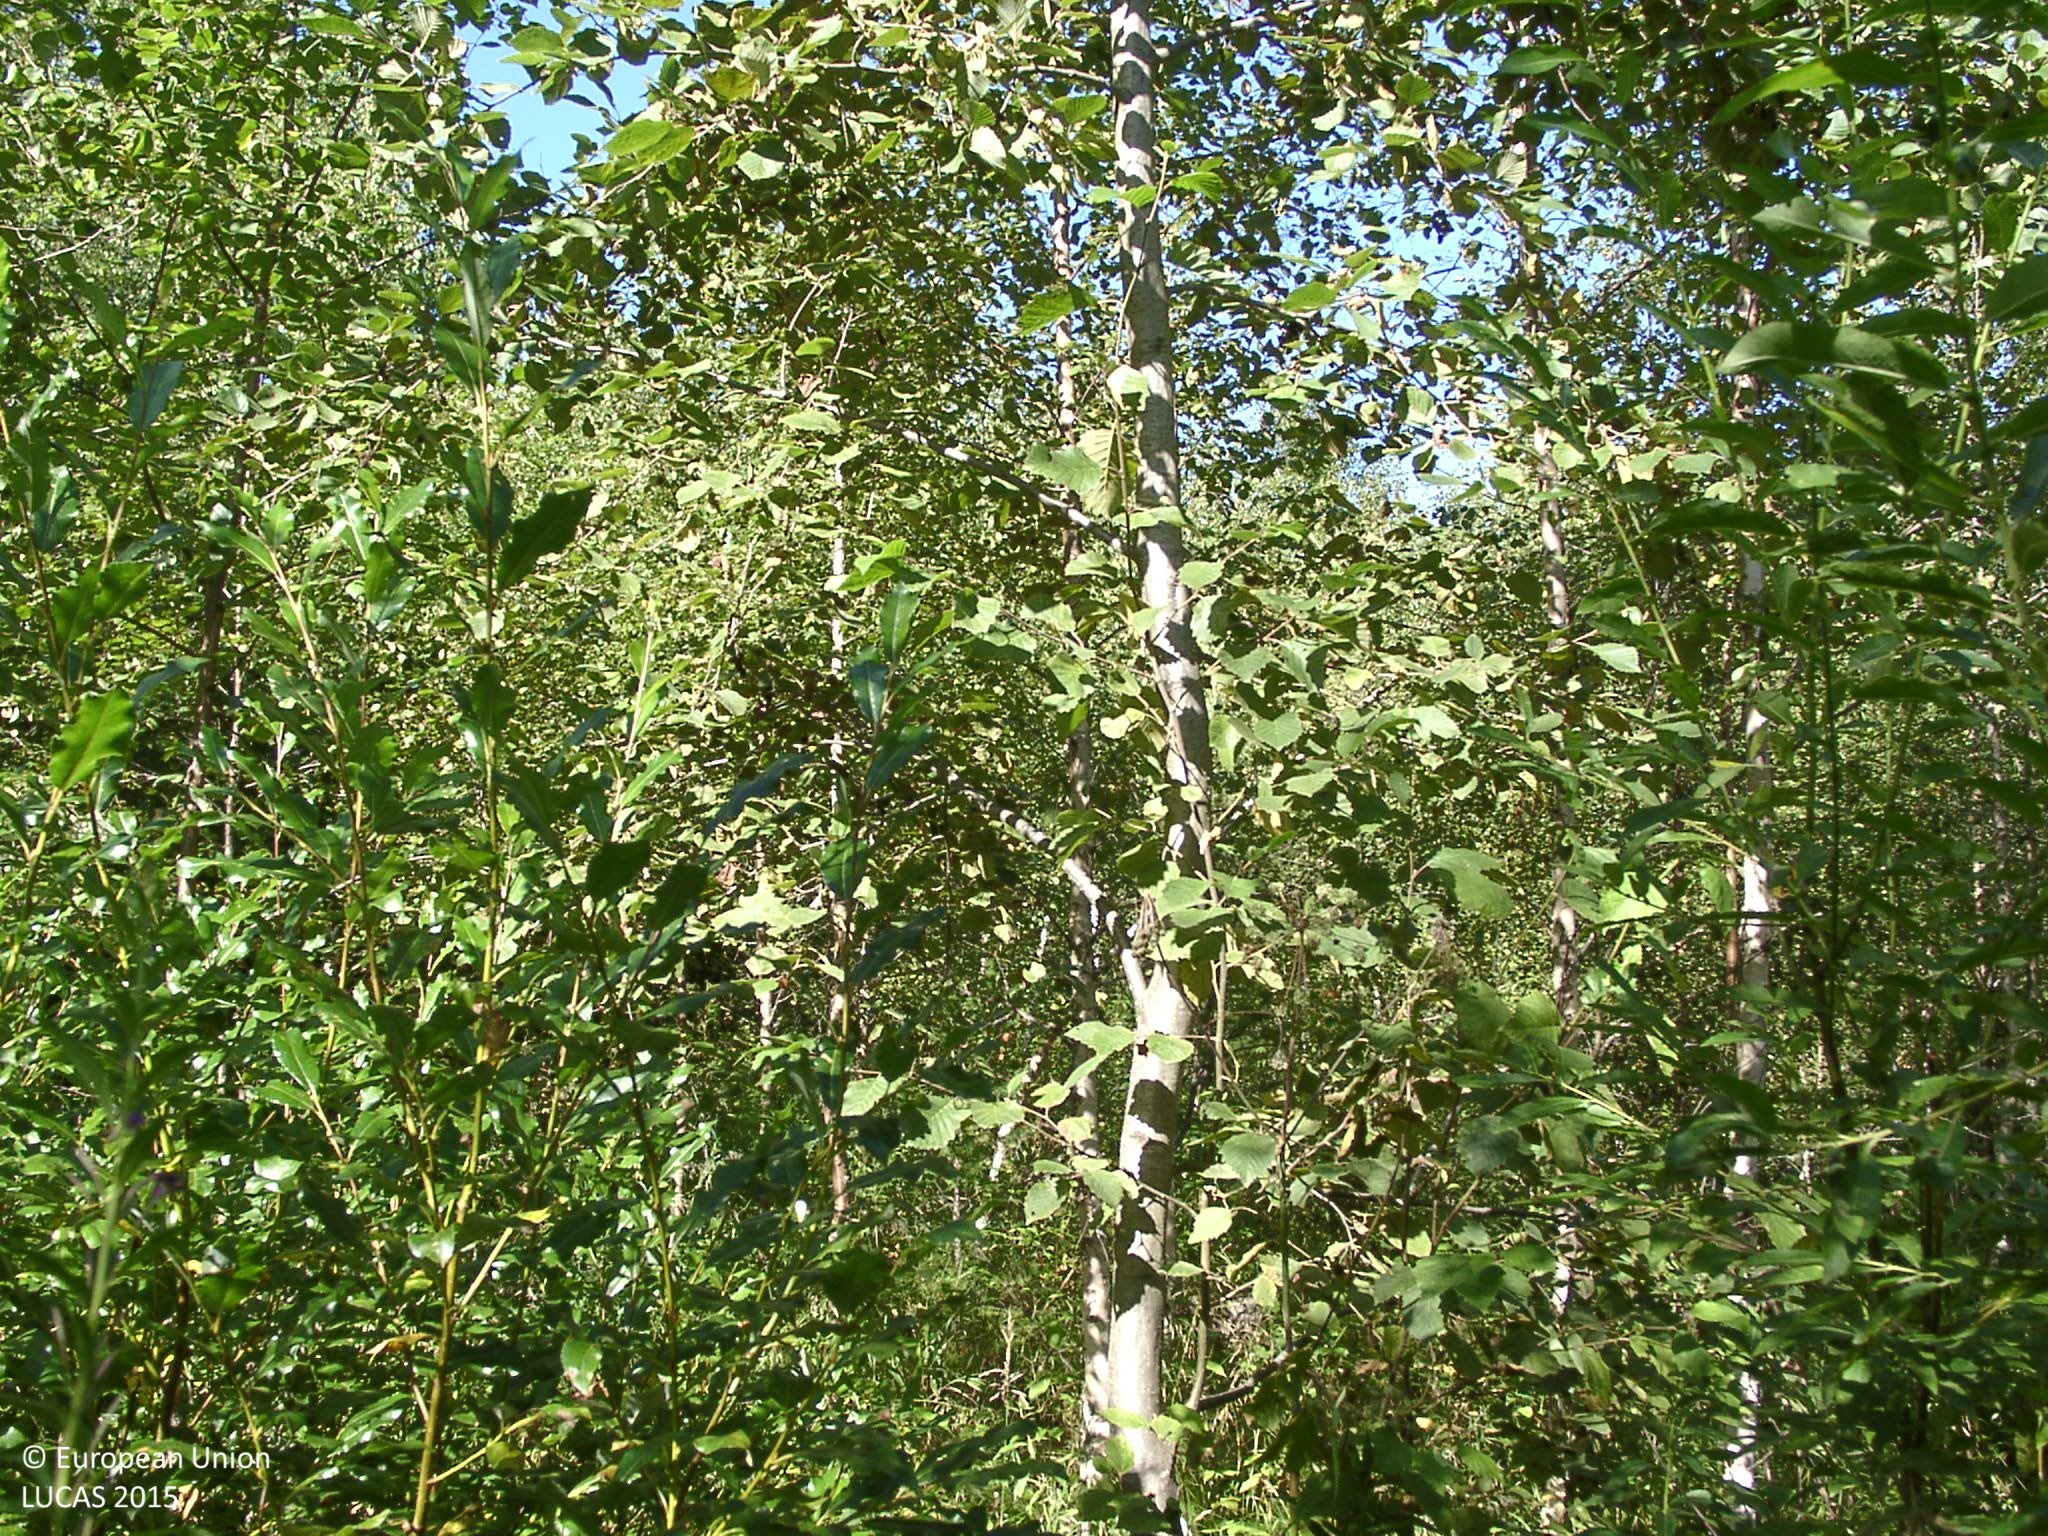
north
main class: Woodland
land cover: Broadleaved woodland
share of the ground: 50 - 75 %
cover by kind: broadleaved forest trees 60 %, shrubs 20 %, herbaceous plants 20 %
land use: Forestry
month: August
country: FI
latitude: 62.3703
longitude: 25.3601
